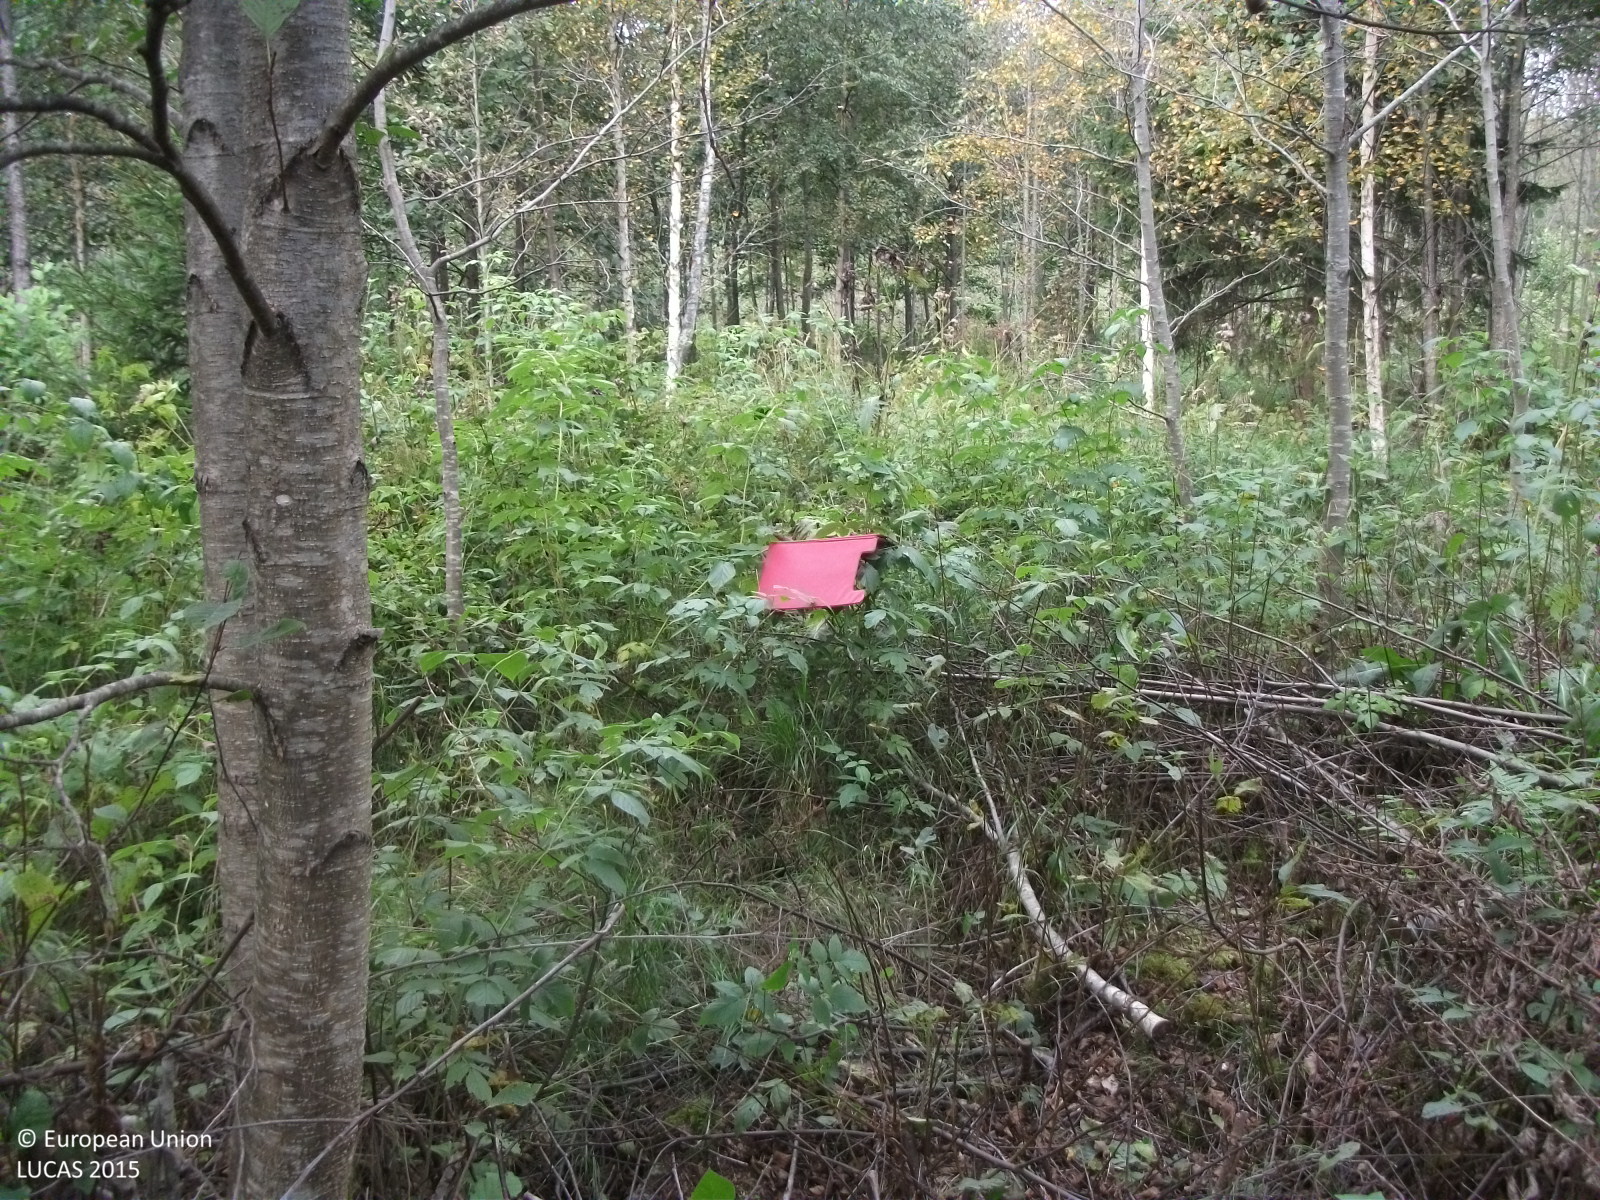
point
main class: Woodland
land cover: Broadleaved woodland
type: non-riverine alder, birch or aspen forest
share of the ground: 50 - 75 %
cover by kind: broadleaved forest trees 70 %, herbaceous plants 15 %, shrubs 10 %, coniferous forest trees 5 %
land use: Forestry
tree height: > 5 m
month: September
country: LV
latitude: 57.9352
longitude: 24.8748
